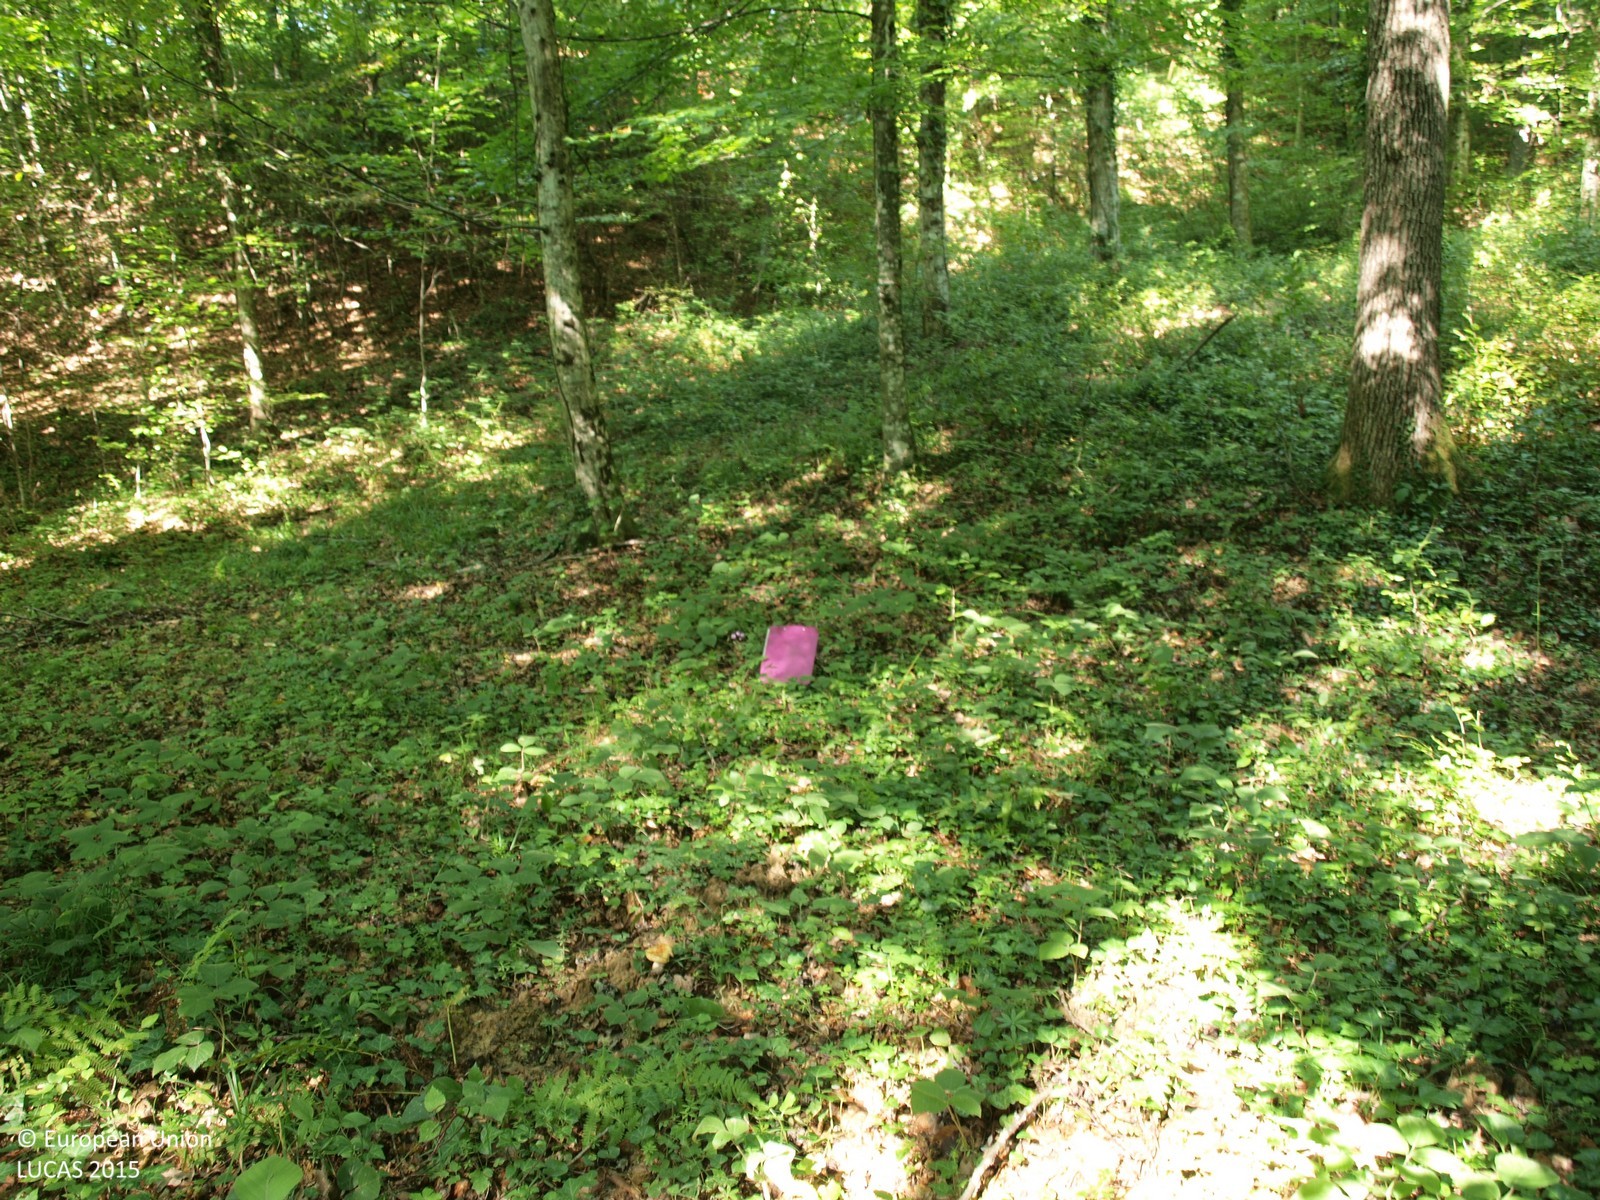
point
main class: Woodland
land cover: Broadleaved woodland
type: mesophytic deciduous forest
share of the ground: > 75 %
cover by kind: broadleaved forest trees 100 %
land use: Forestry
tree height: > 5 m
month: September
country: HR
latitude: 45.5488
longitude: 16.0301
